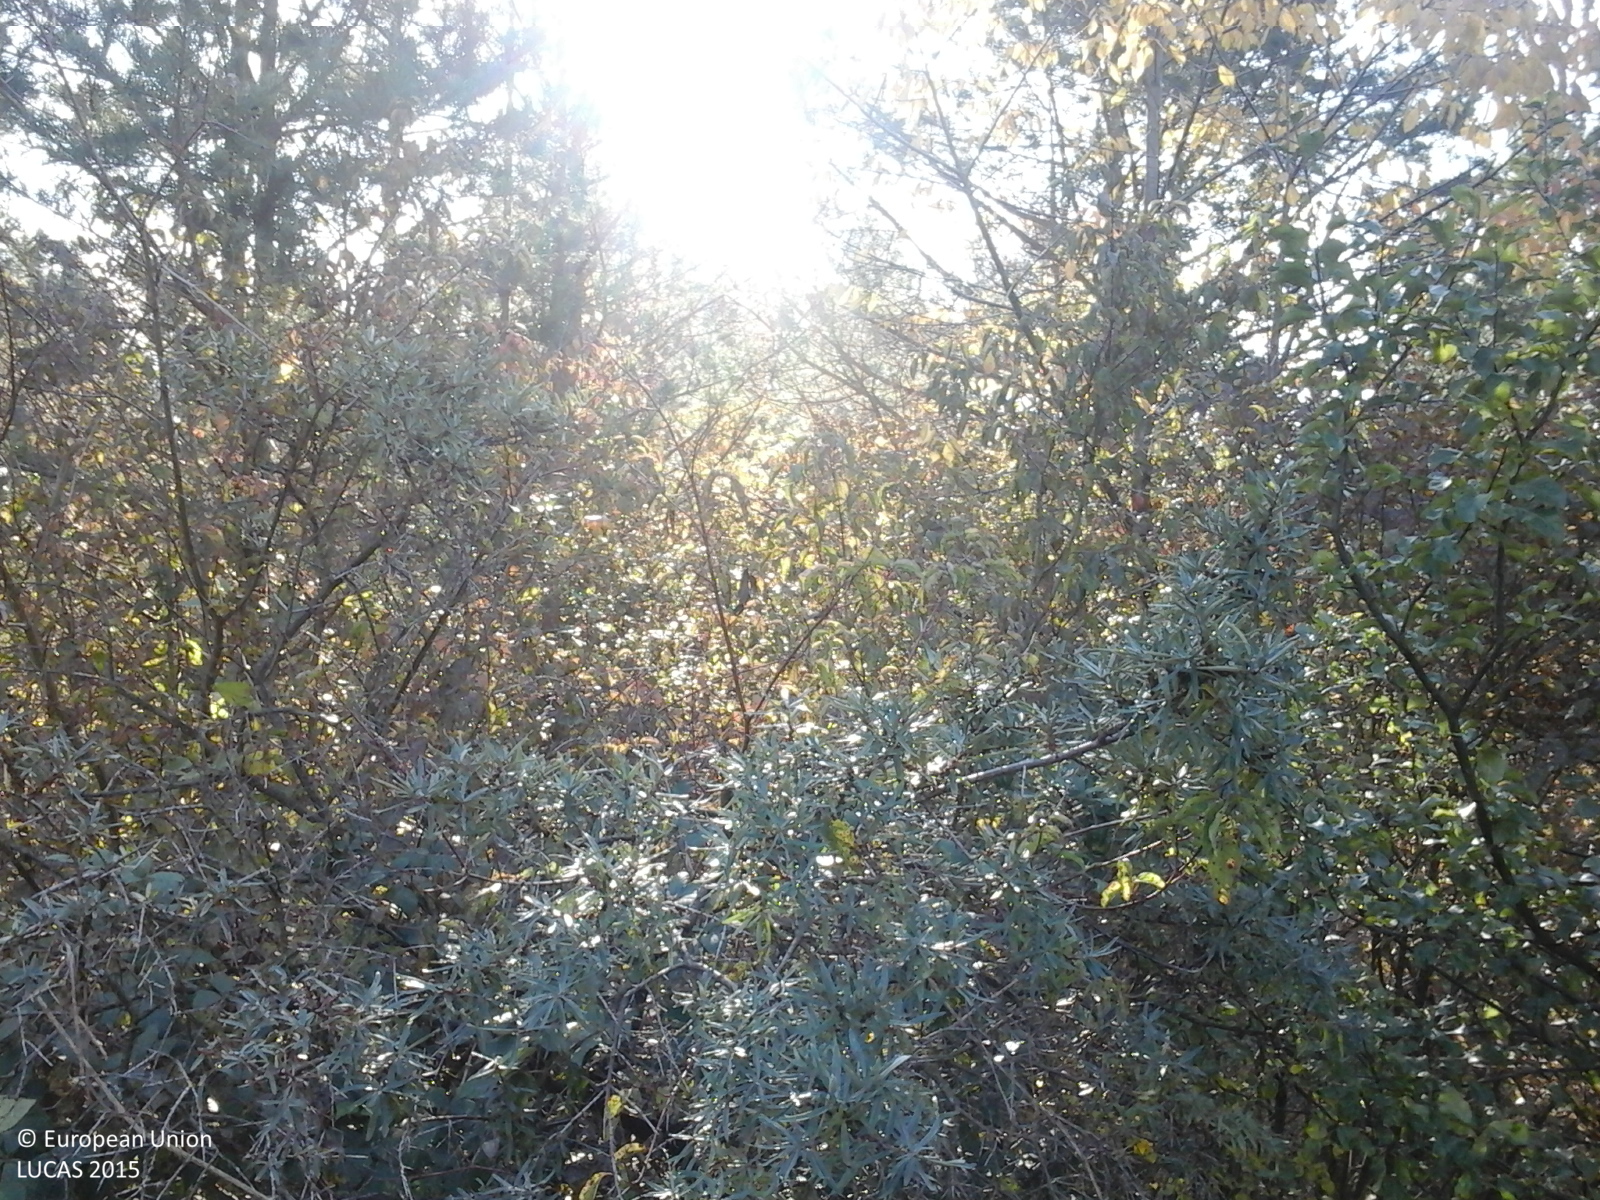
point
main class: Woodland
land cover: Pine dominated coniferous woodland
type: alpine coniferous forest
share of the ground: > 75 %
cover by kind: coniferous forest trees 100 %
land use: Forestry
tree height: > 5 m
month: October
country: RO
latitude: 45.9866
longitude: 26.6713
